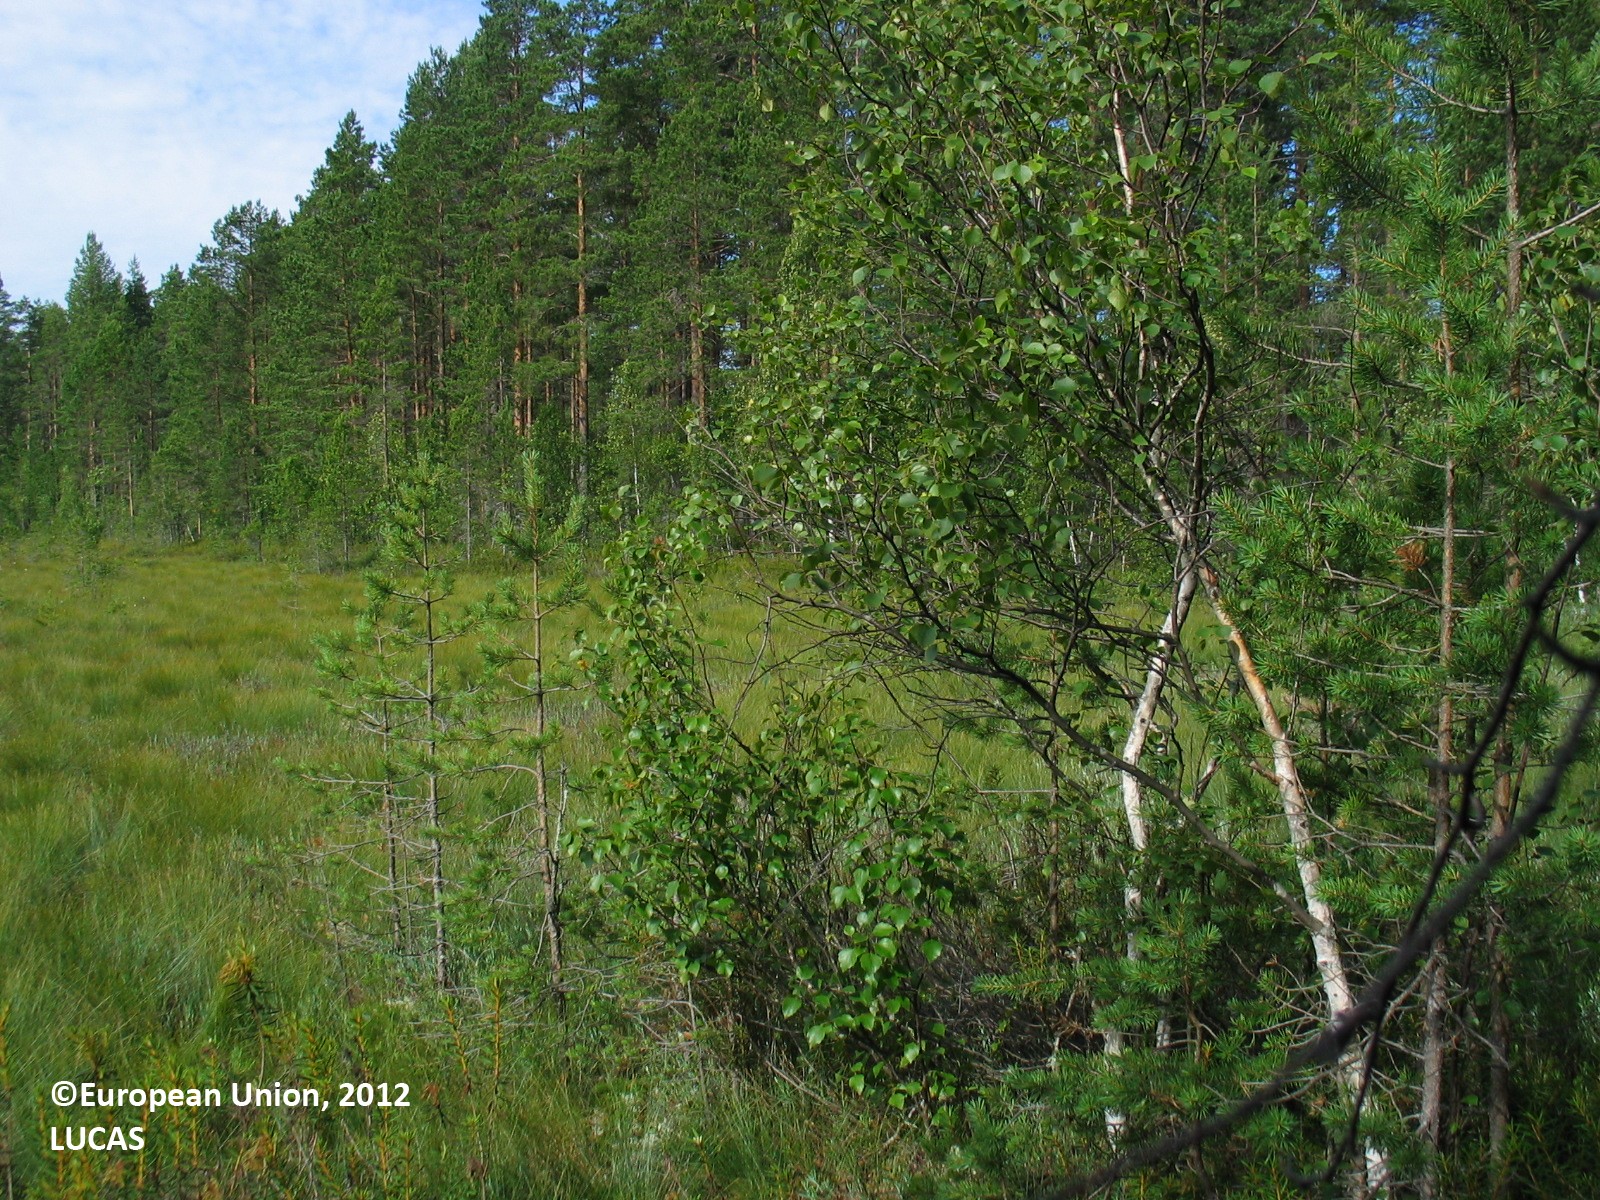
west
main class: Woodland
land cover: Other mixed woodland
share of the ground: 50 - 75 %
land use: Forestry
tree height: > 5 m
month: July
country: FI
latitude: 64.6685
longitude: 26.3856
